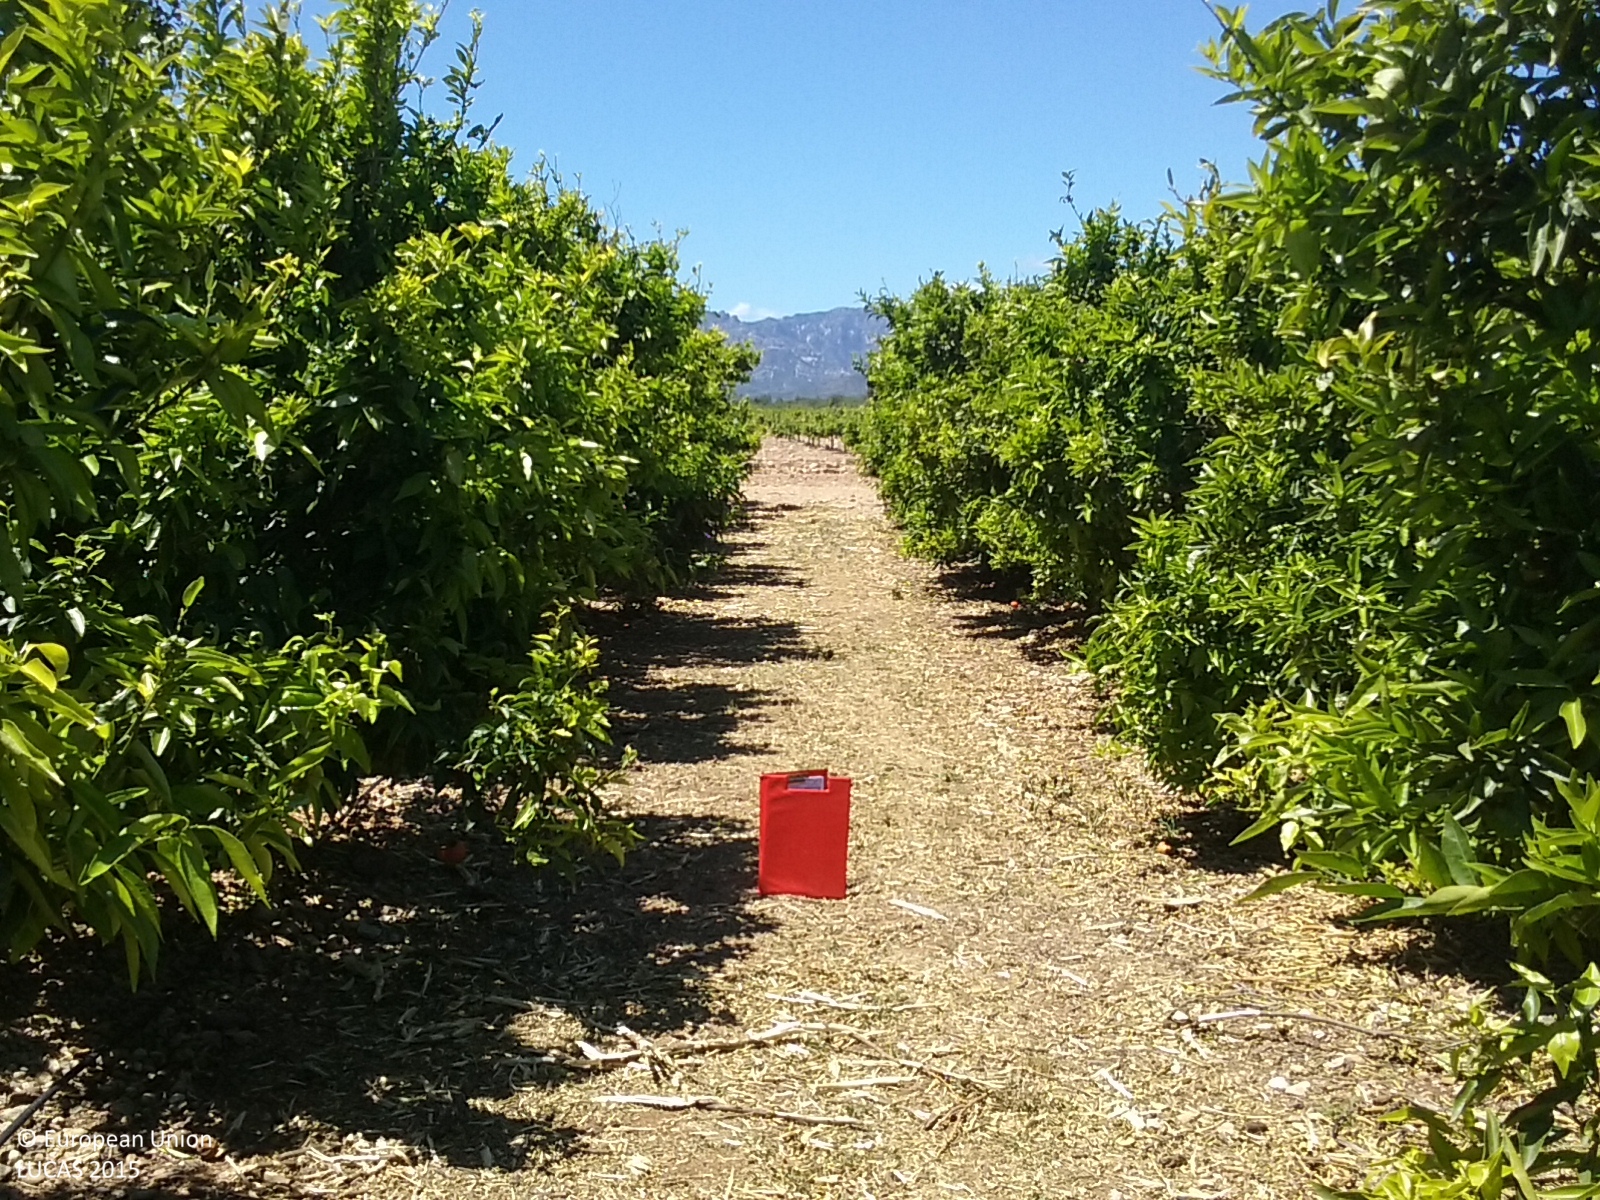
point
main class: Cropland
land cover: Oranges
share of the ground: 50 - 75 %
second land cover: Other bare soil
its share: > 75 %
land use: Agriculture (excluding fallow land and kitchen gardens)
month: May
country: ES
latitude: 40.7278
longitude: 0.4394
